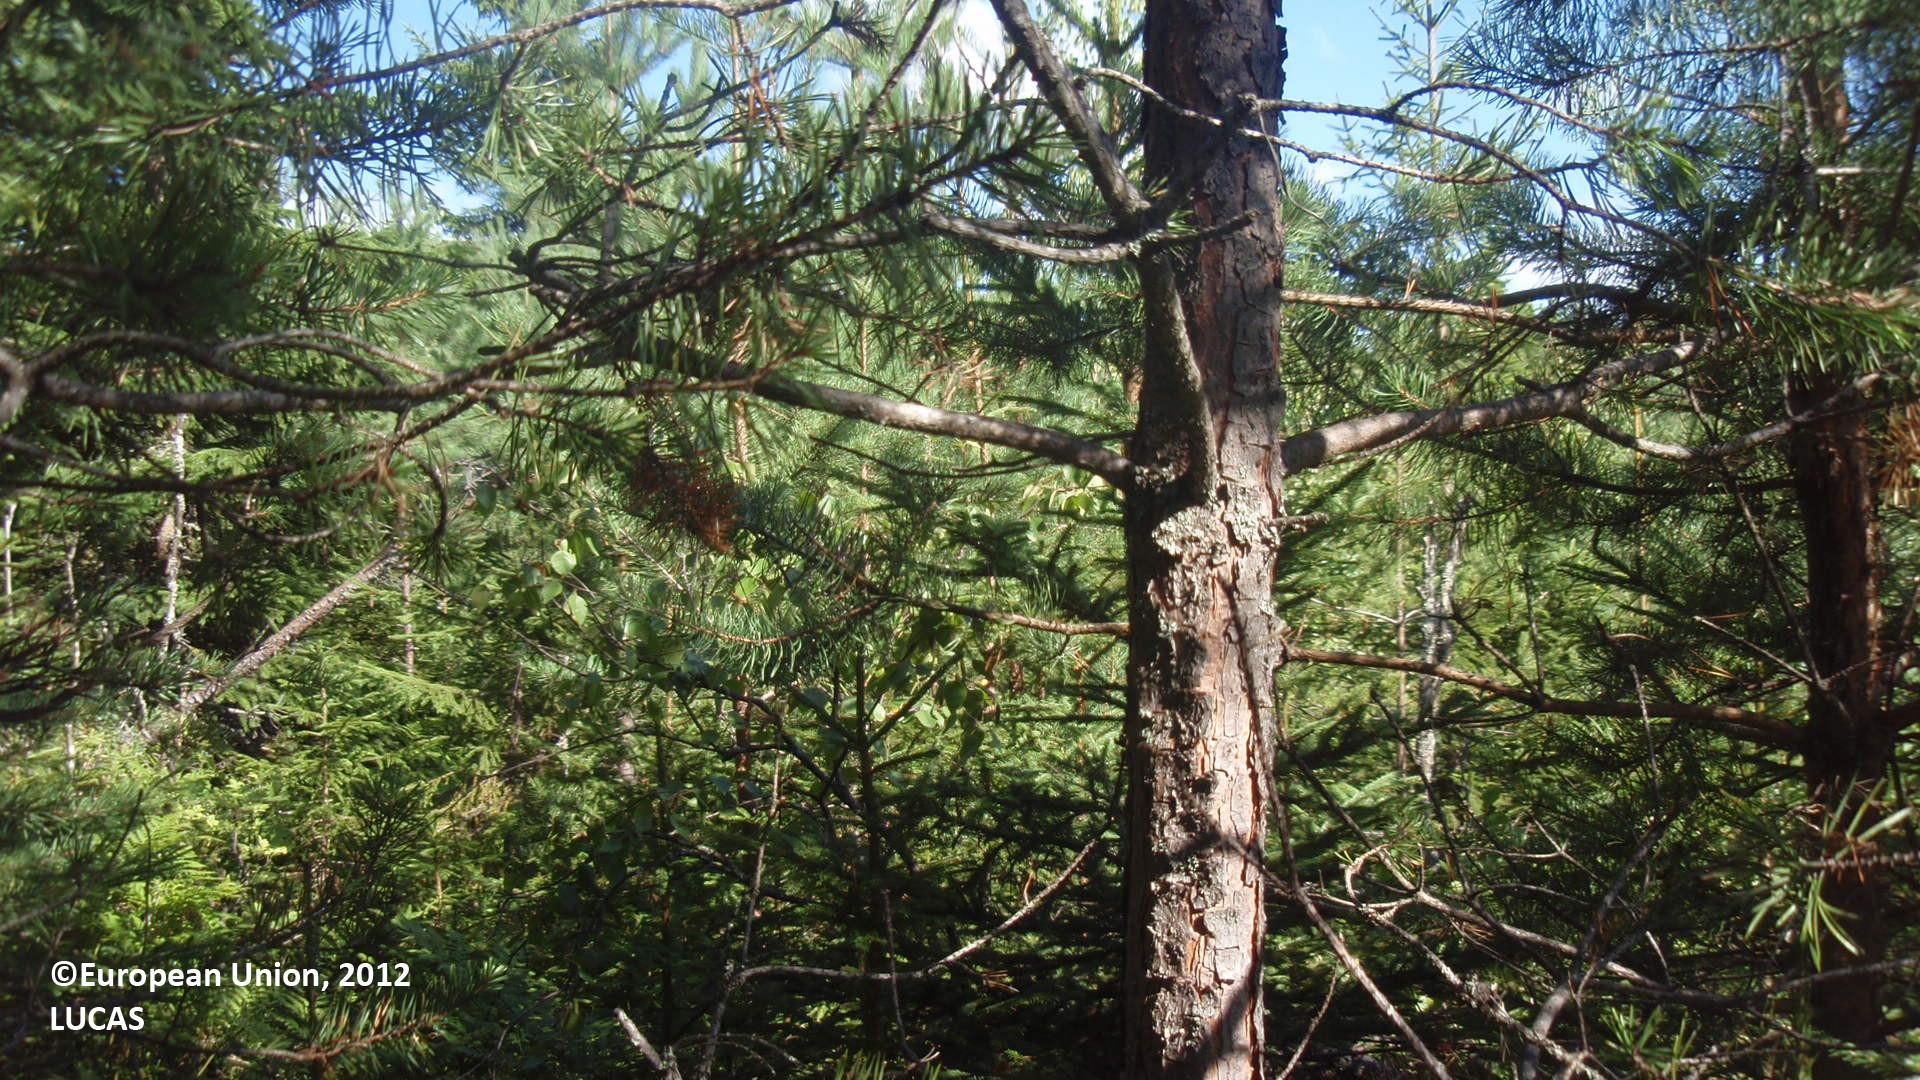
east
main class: Woodland
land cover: Pine dominated mixed woodland
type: boreal forest
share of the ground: 50 - 75 %
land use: Forestry
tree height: > 5 m
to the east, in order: Pine dominated mixed woodland; Broadleaved woodland; Pine dominated mixed woodland; Tracks; Spruce dominated mixed woodland
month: August
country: FI
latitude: 61.5058
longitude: 27.7547
